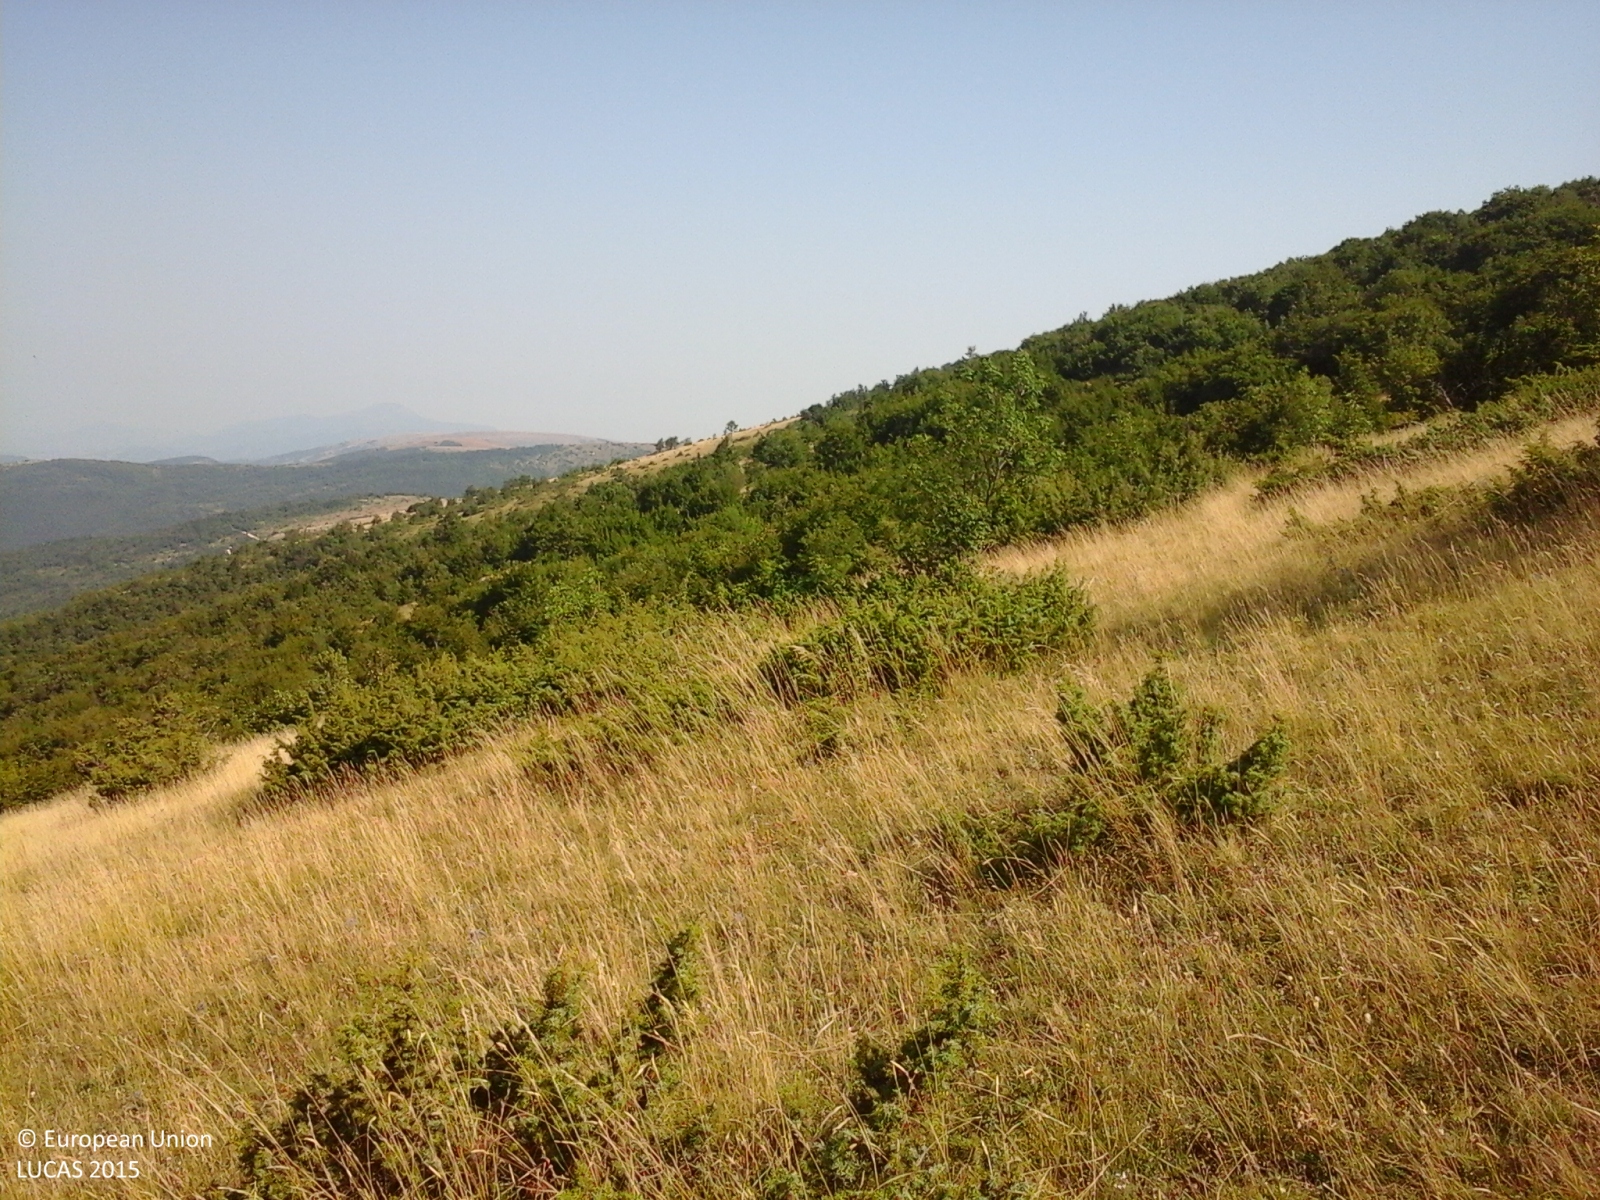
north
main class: Shrubland
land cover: Shrubland with sparse tree cover
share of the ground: > 75 %
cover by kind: herbaceous plants 60 %, shrubs 35 %, coniferous forest trees 5 %
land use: Agriculture (excluding fallow land and kitchen gardens)
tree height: < 5 m
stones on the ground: > 50 %
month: August
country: IT
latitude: 43.0742
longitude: 13.1721
